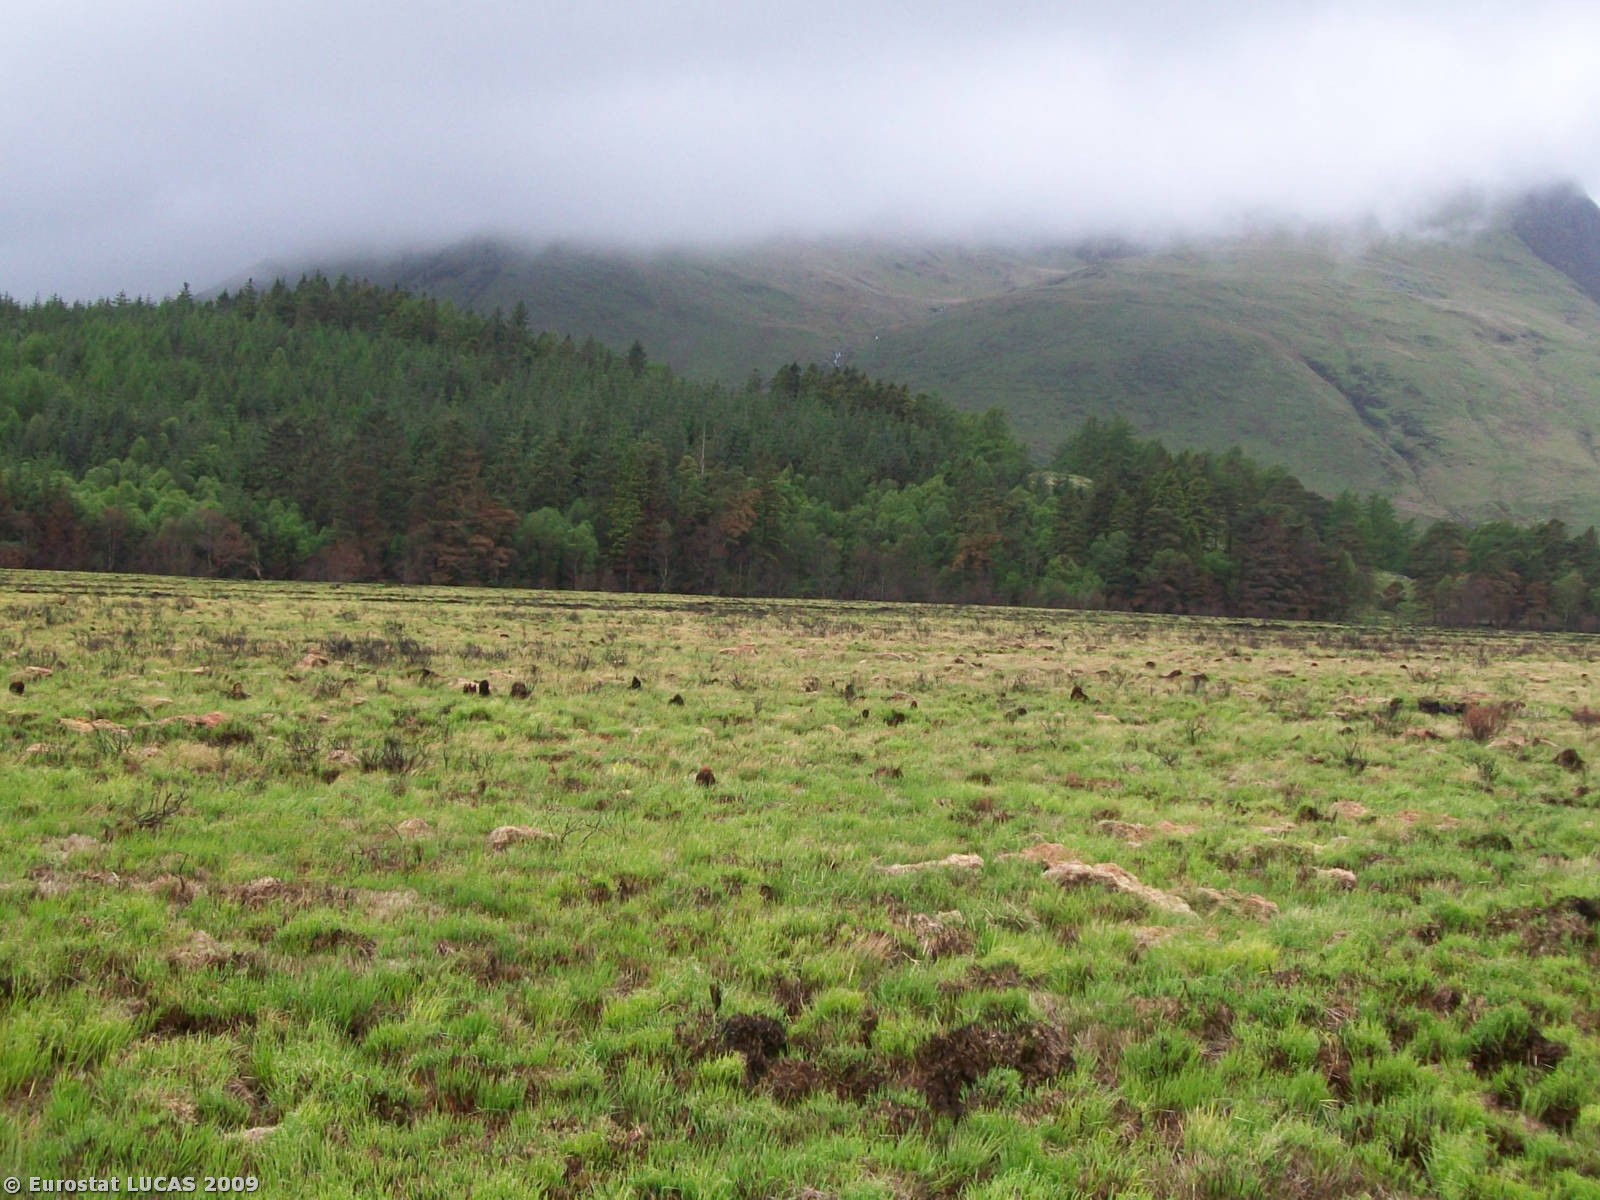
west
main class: Wetlands
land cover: Peatbogs
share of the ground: > 75 %
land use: Unused
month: May
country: GB
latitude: 53.0424
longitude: -4.1322
